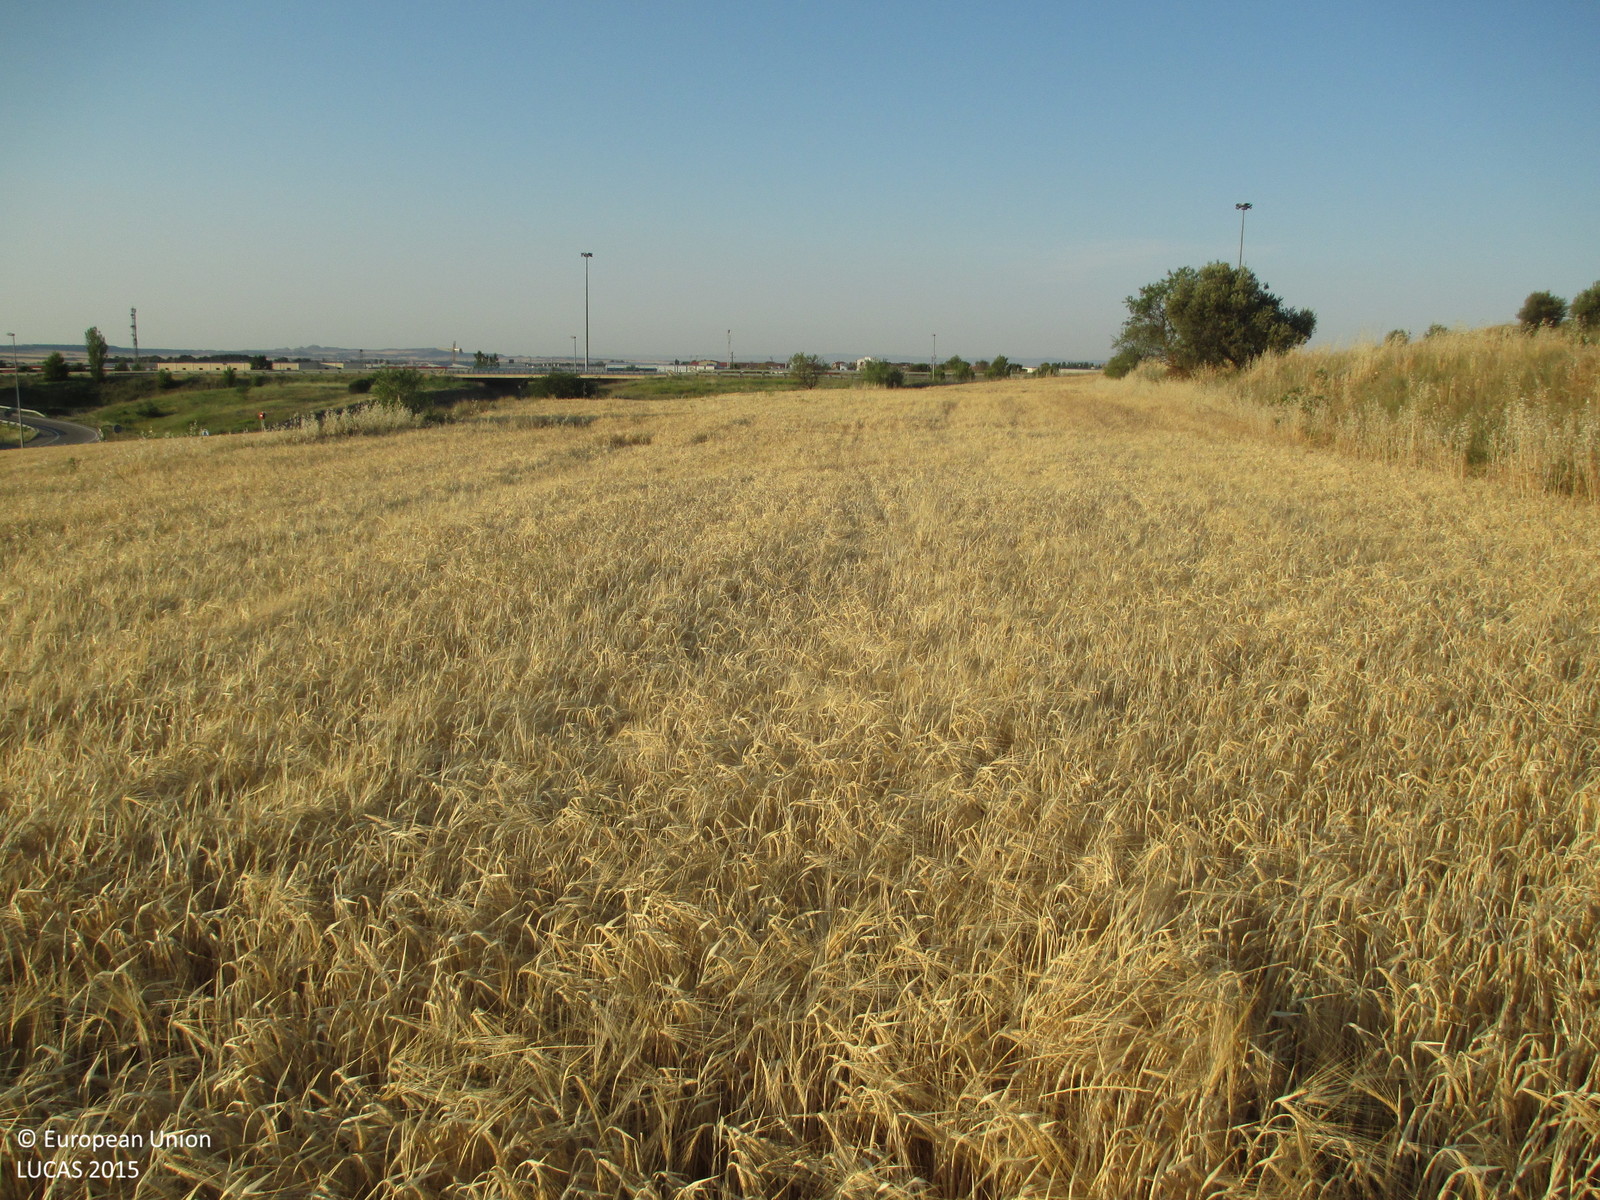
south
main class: Cropland
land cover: Barley
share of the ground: > 75 %
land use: Agriculture (excluding fallow land and kitchen gardens)
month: June
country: ES
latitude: 42.1542
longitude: -0.3941
